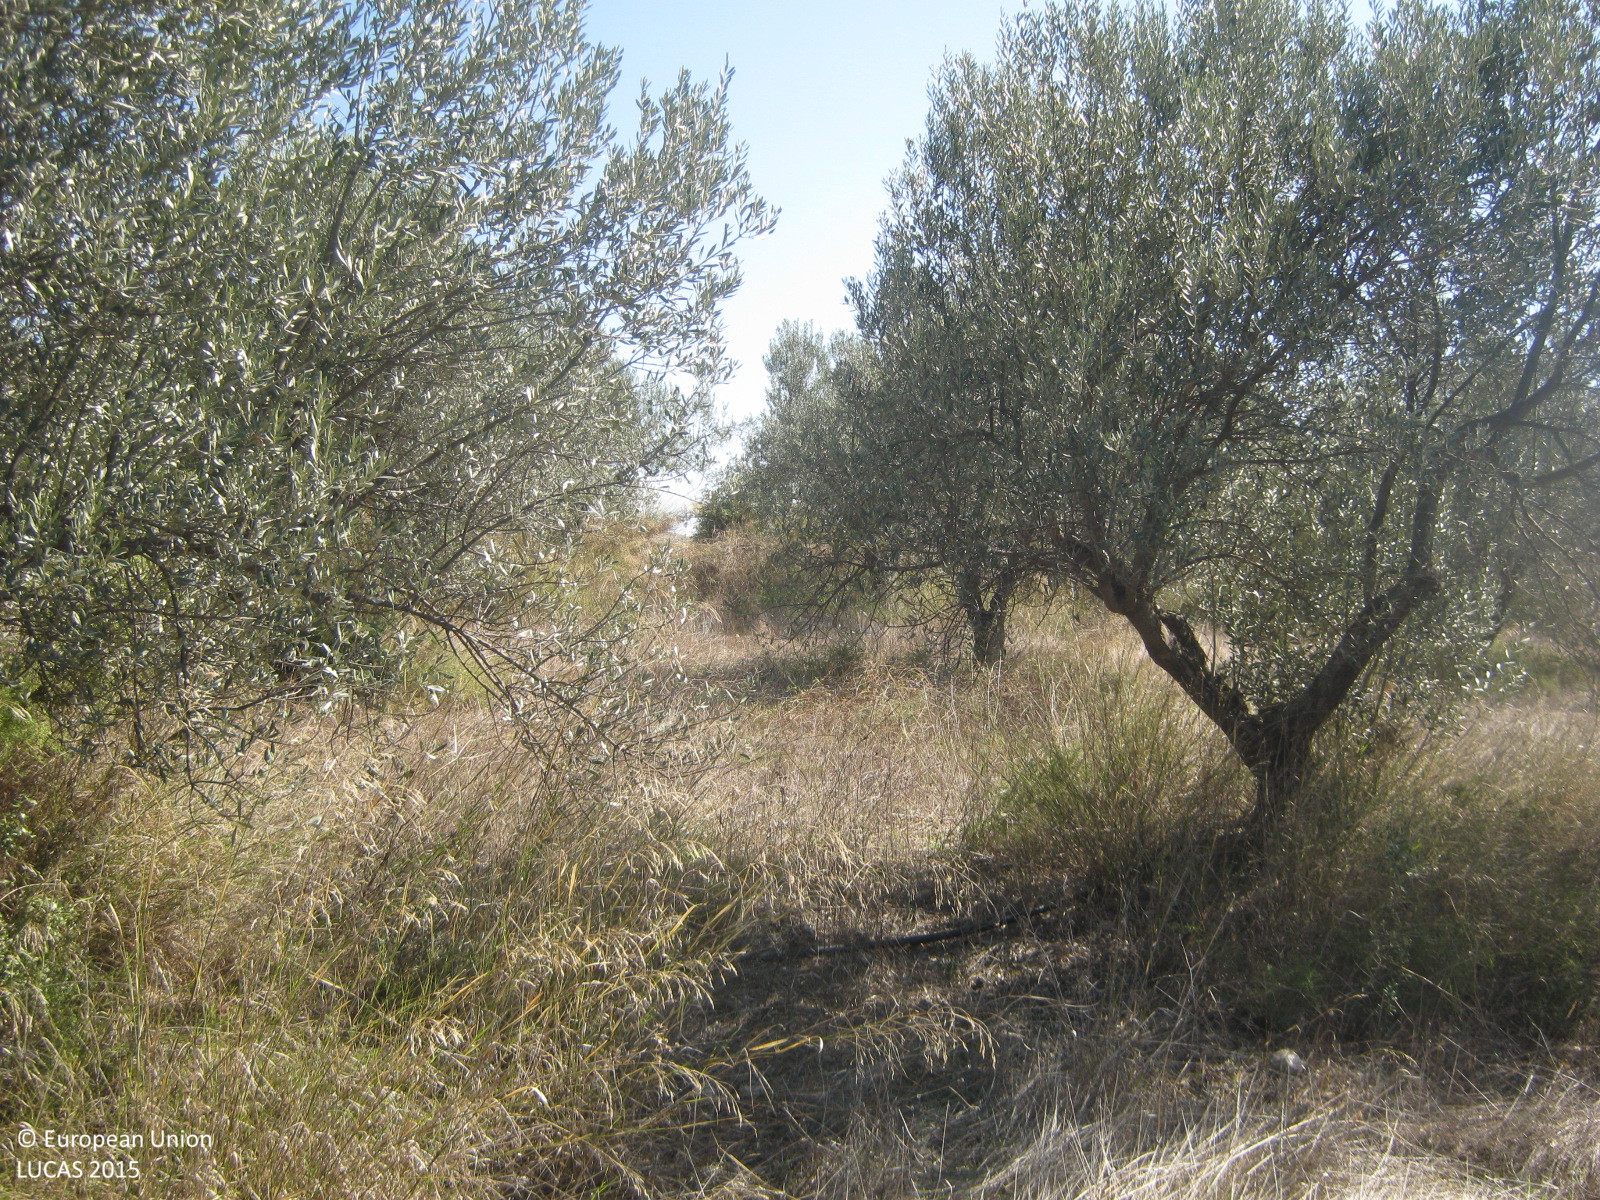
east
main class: Cropland
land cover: Olive groves
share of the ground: > 75 %
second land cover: Spontaneously vegetated surfaces
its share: 25 - 50 %
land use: Agriculture (excluding fallow land and kitchen gardens)
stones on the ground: 10 - 25 %
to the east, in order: Olive groves; Spontaneously vegetated surfaces; Other bare soil; Tracks; Other bare soil; Shruby margins; Spontaneously vegetated surfaces; Olive groves; Spontaneously vegetated surfaces; Olive groves; Shrubland without tree cover; Olive groves
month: October
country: GR
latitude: 37.7221
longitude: 22.7994
